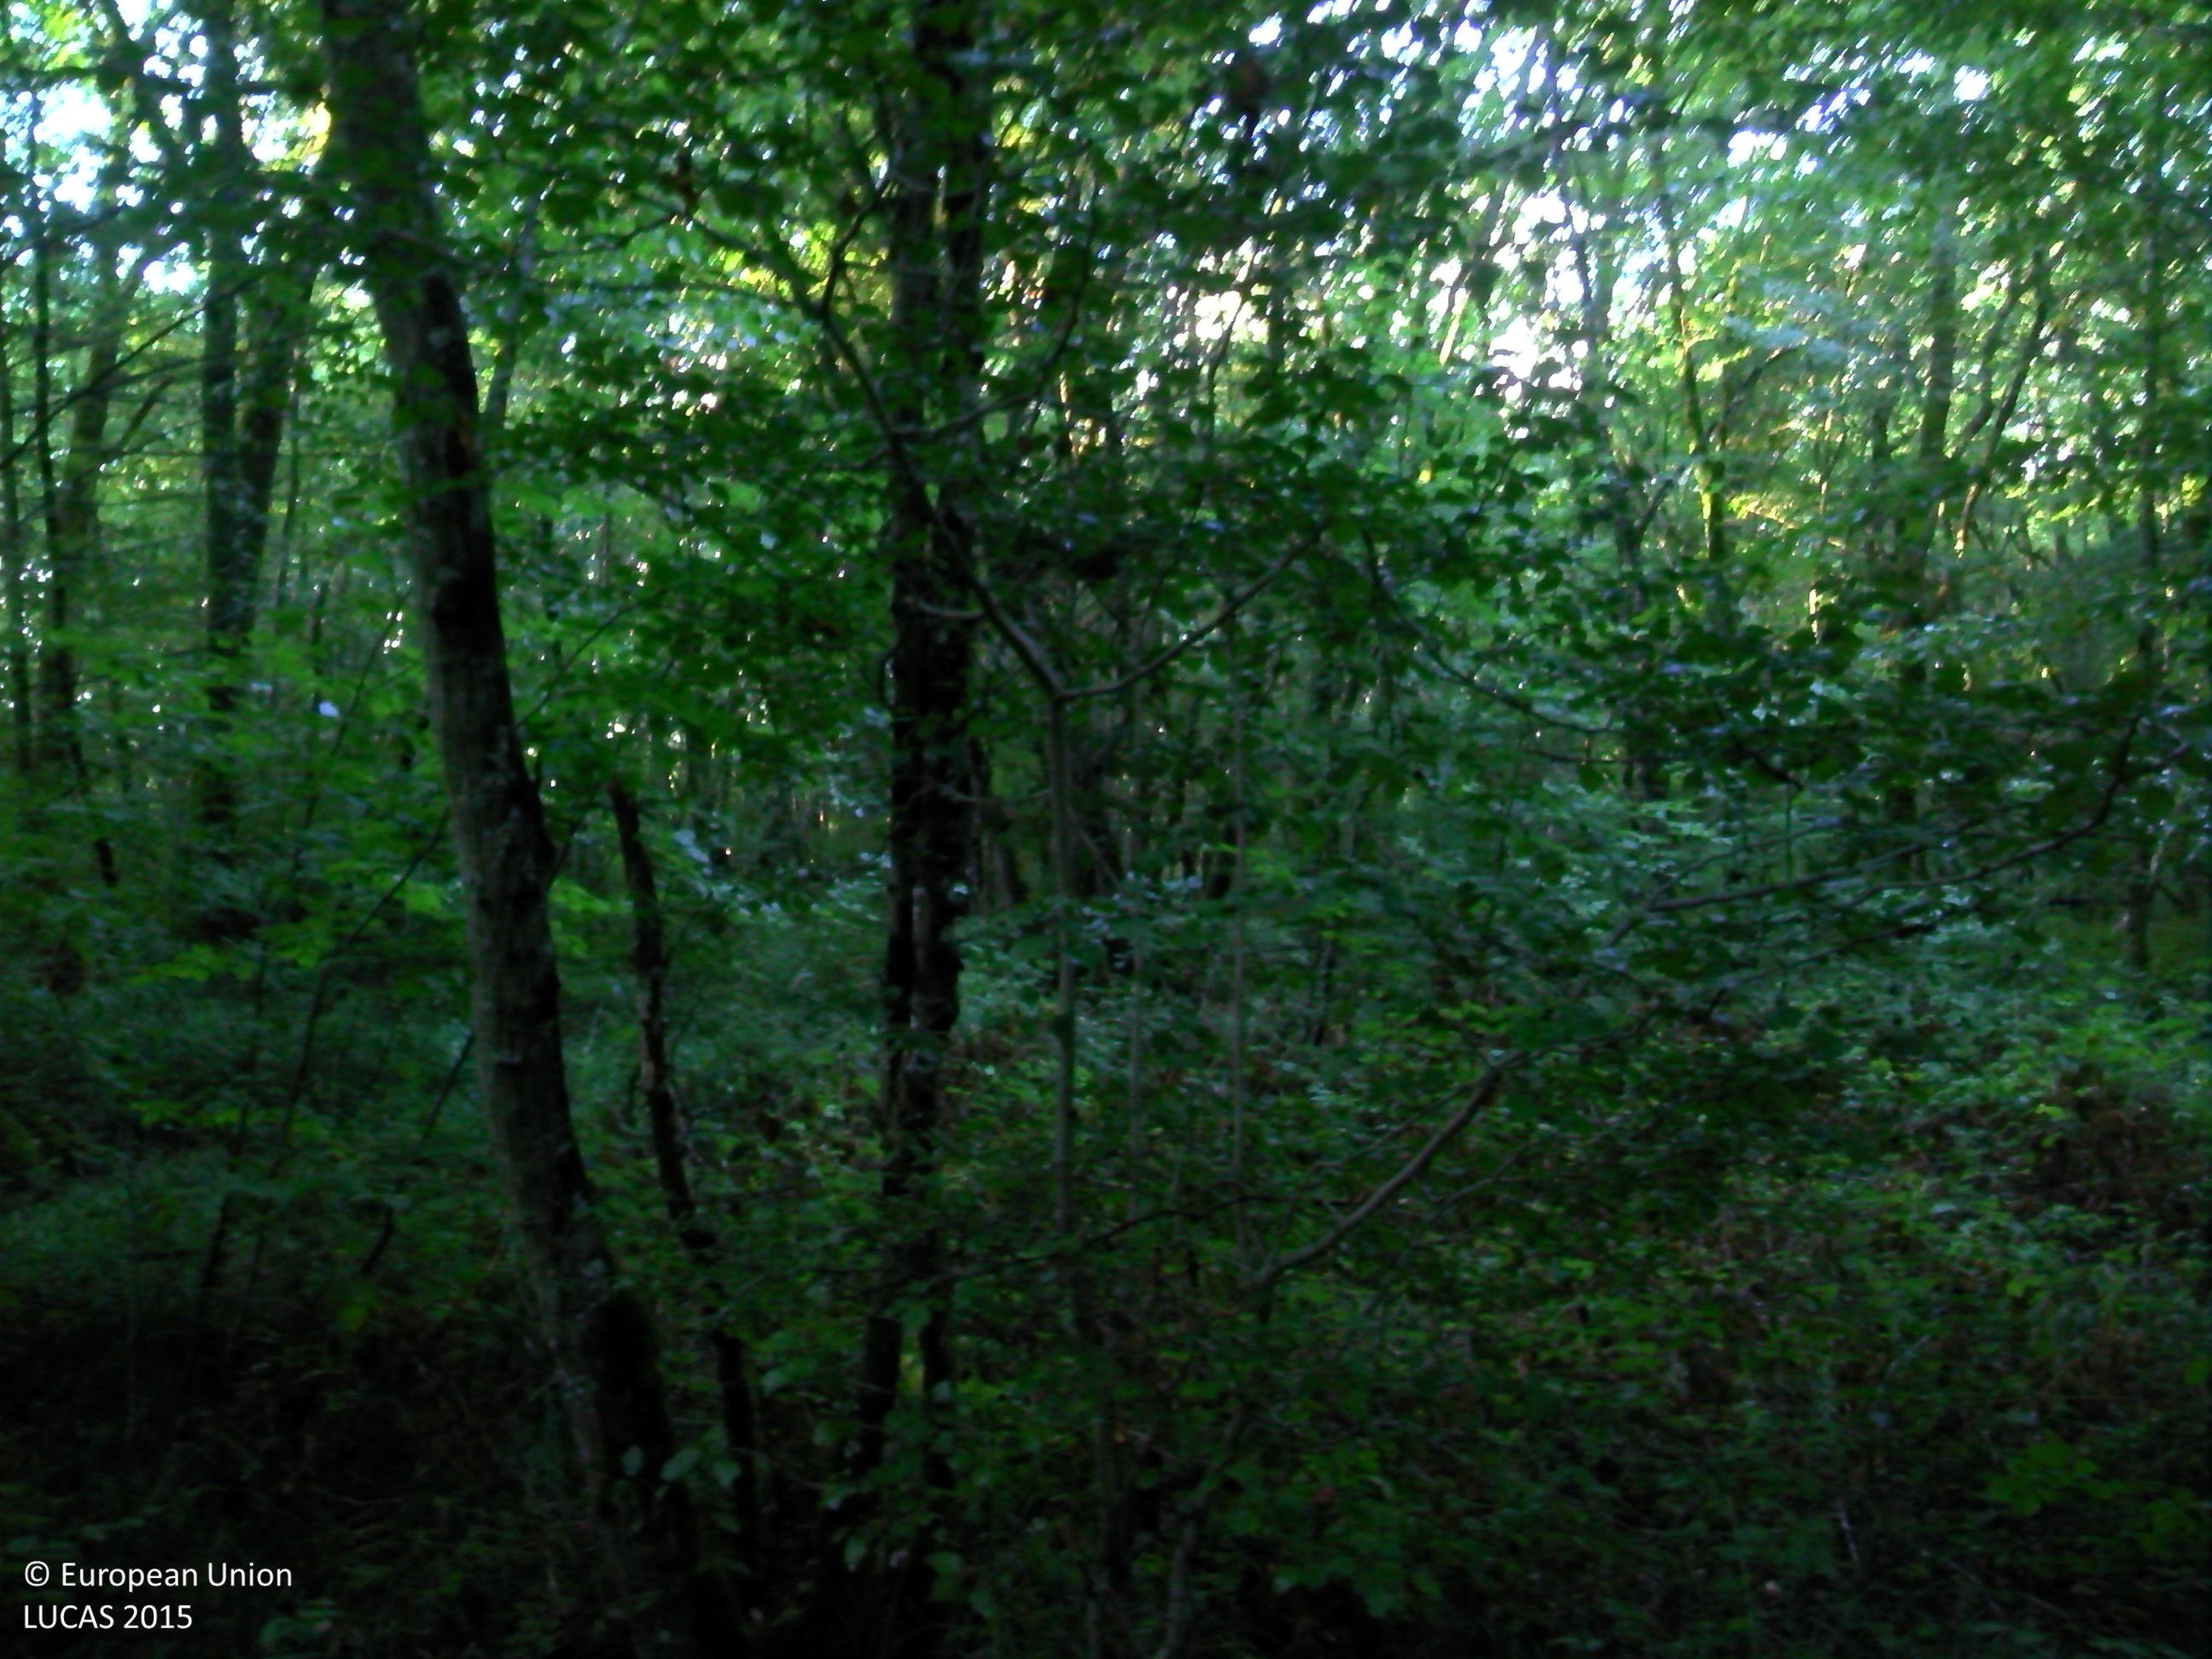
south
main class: Woodland
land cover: Broadleaved woodland
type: mesophytic deciduous forest
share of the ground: > 75 %
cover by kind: broadleaved forest trees 85 %, herbaceous plants 10 %, lichens and mosses 5 %
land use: Forestry
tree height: > 5 m
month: September
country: FR
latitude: 48.1381
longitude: 4.8248
